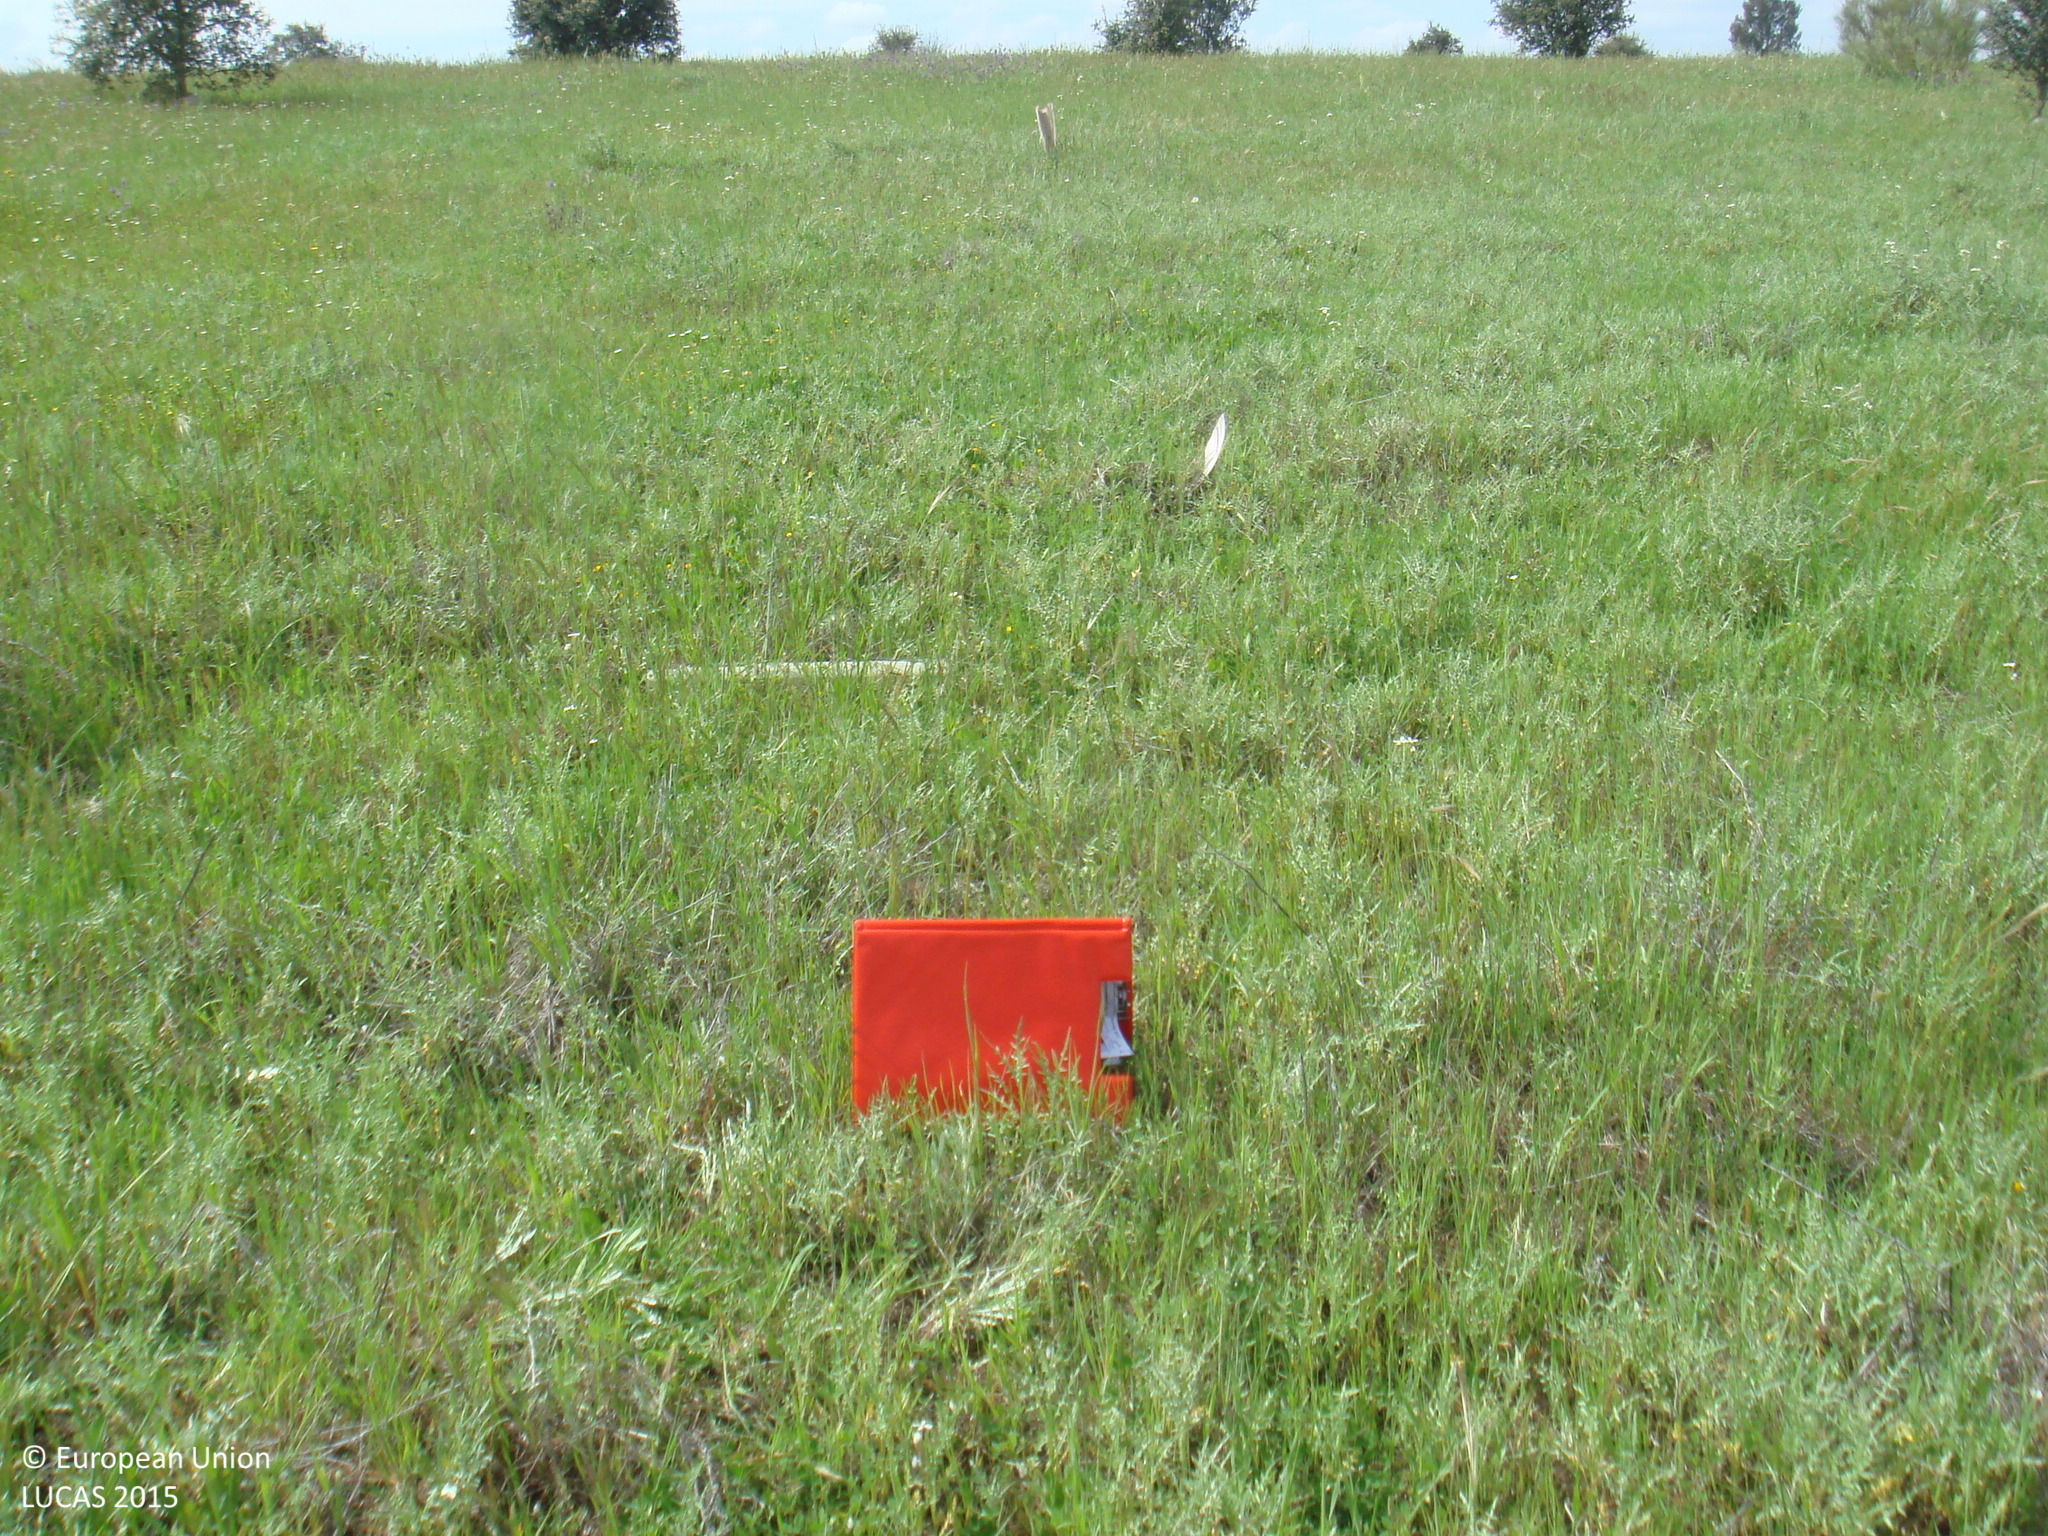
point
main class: Grassland
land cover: Grassland without tree/shrub cover
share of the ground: > 75 %
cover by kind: herbaceous plants 95 %, shrubs 5 %
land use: Agriculture (excluding fallow land and kitchen gardens)
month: April
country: ES
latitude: 38.1965
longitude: -5.0618
